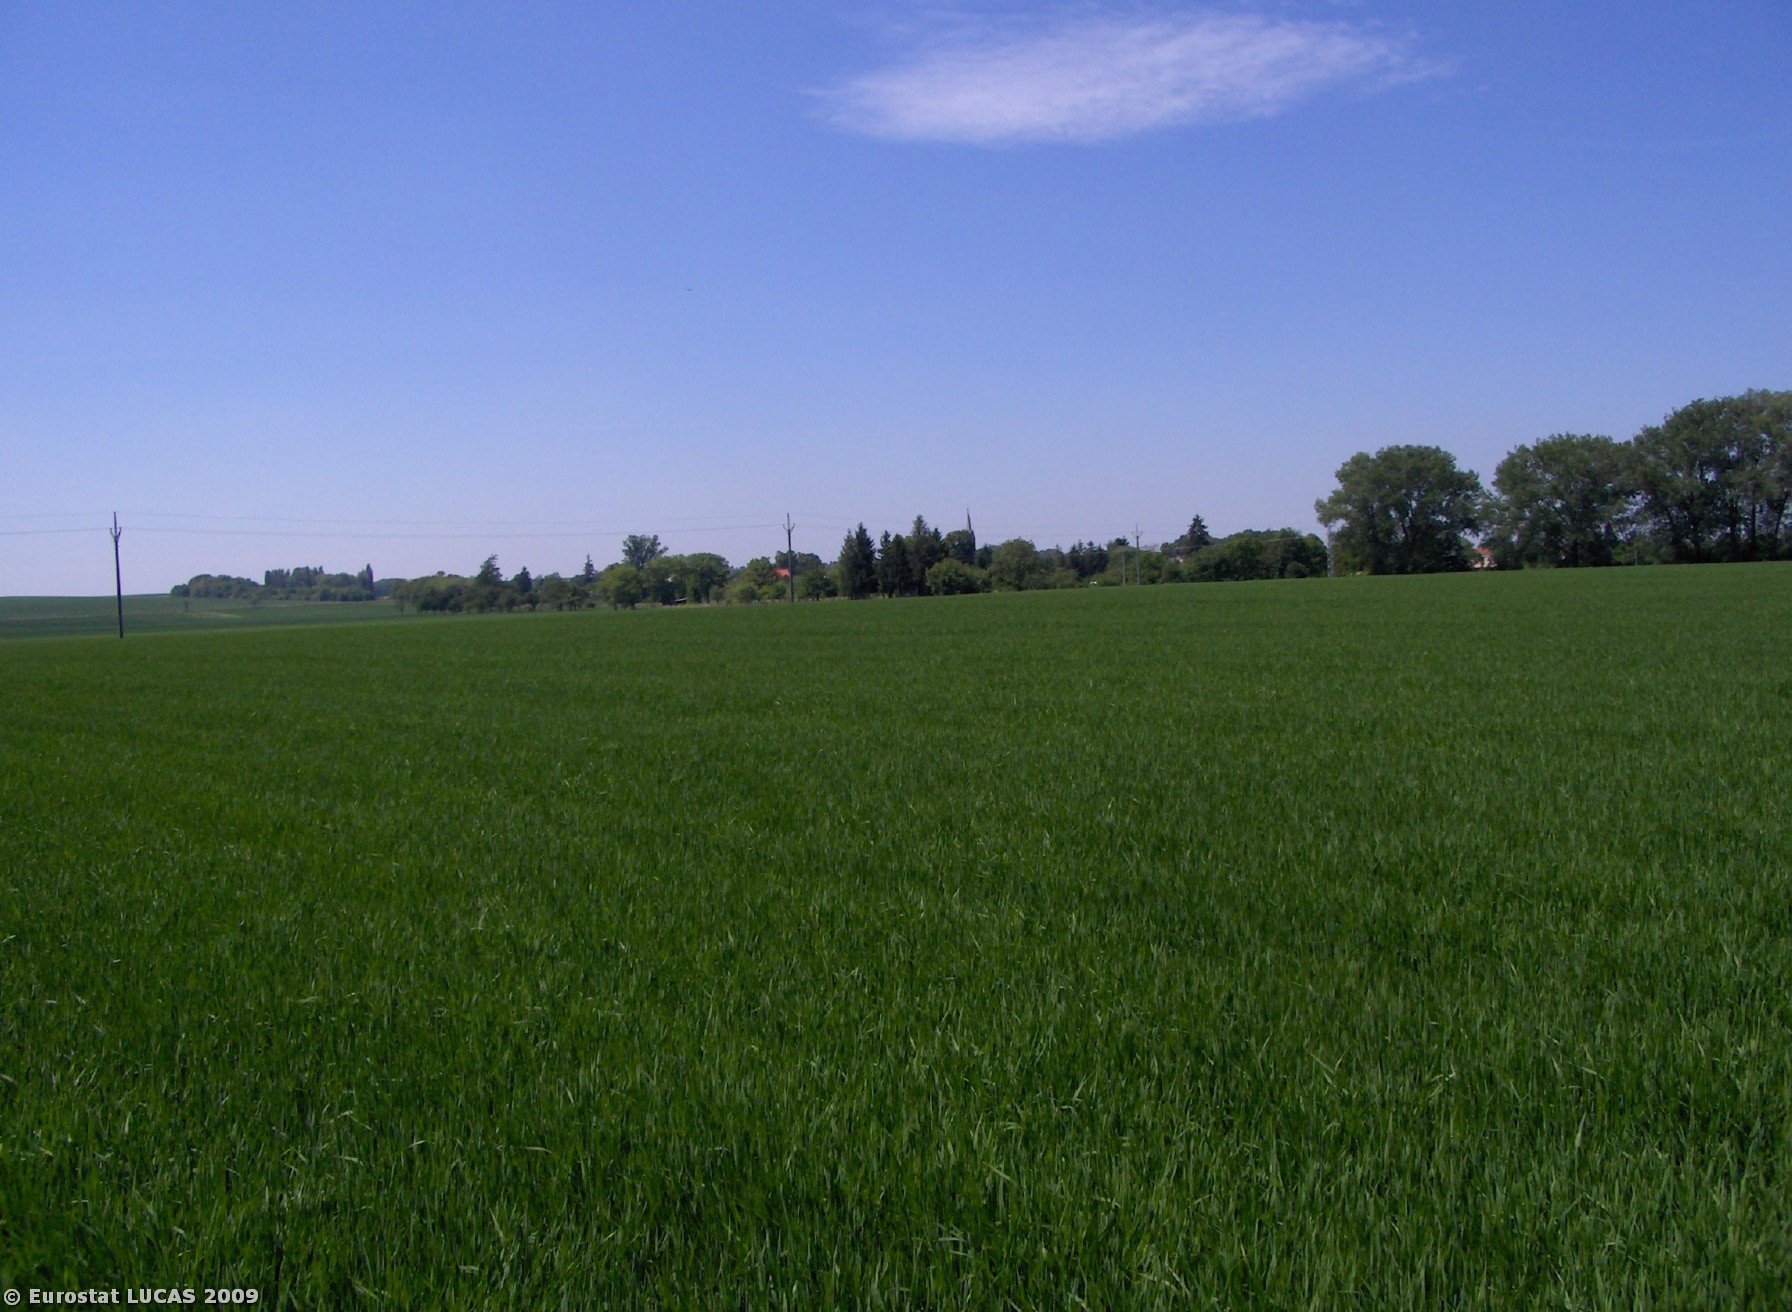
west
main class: Cropland
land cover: Barley
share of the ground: > 75 %
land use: Agriculture (excluding fallow land and kitchen gardens)
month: May
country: CZ
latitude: 49.3922
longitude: 17.2715
